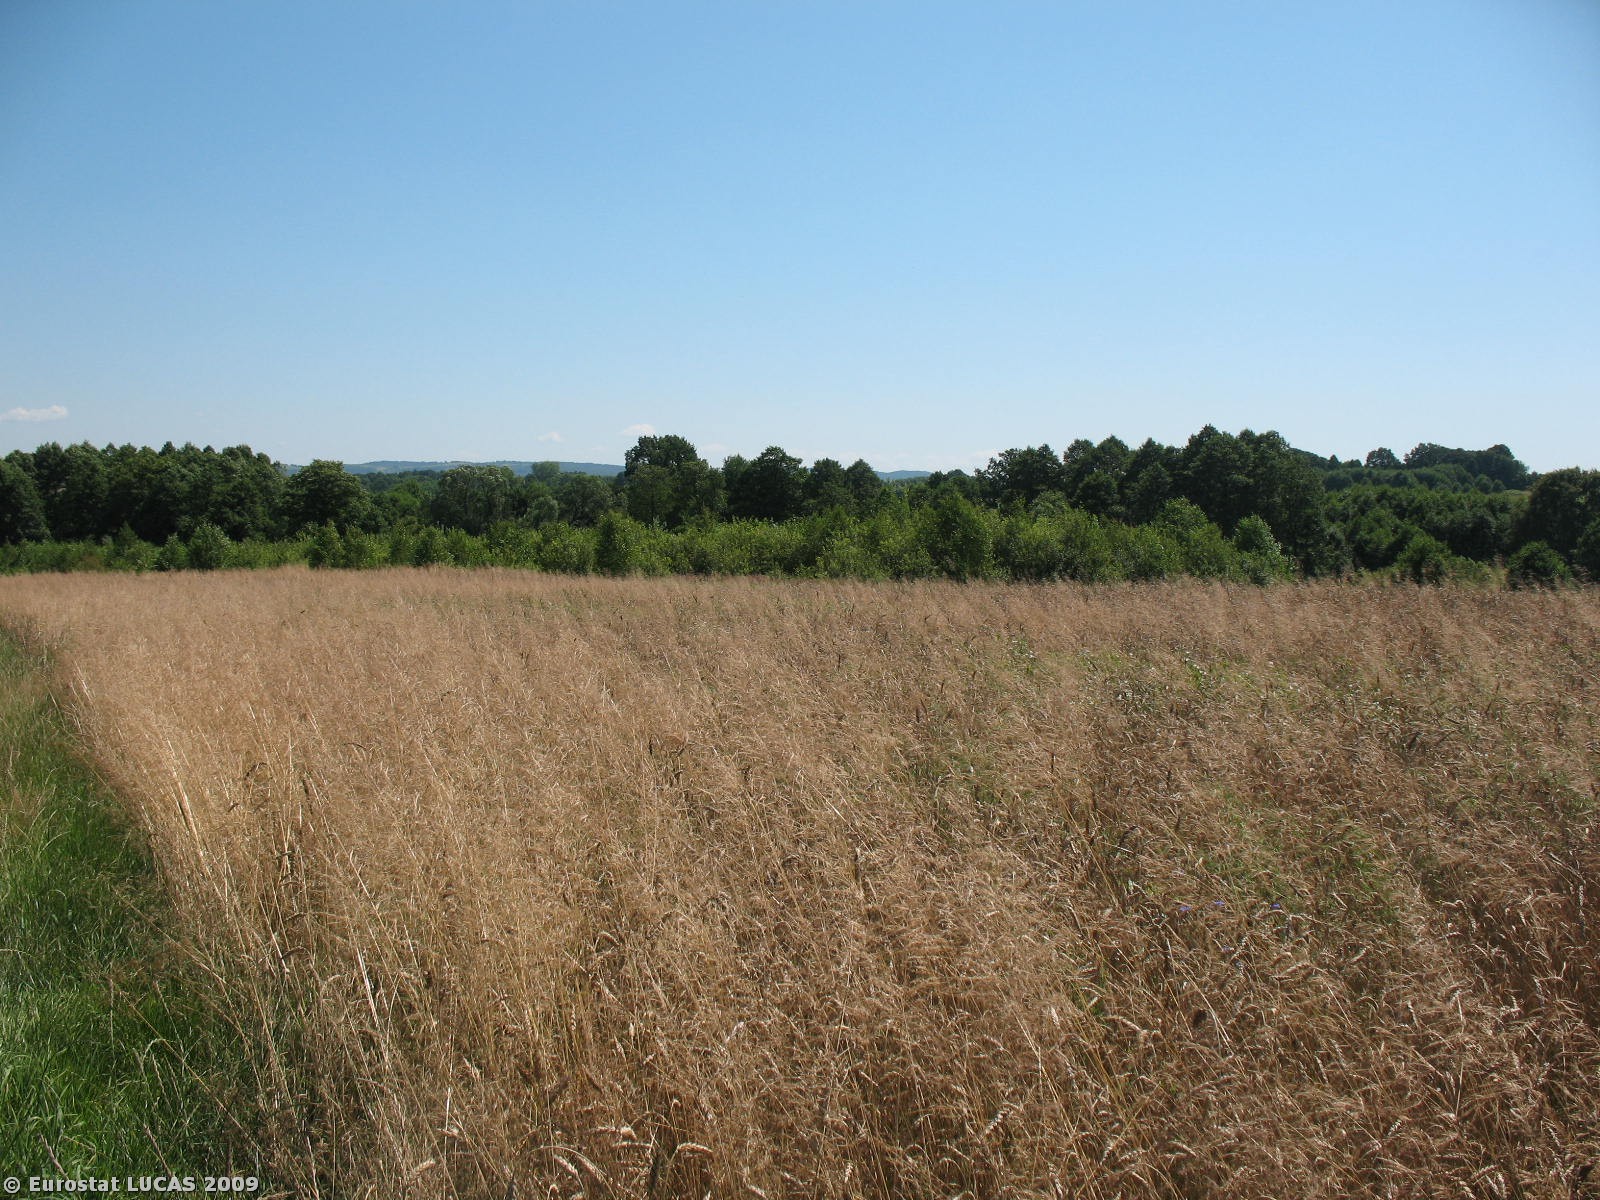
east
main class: Grassland
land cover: Grassland without tree/shrub cover
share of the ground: > 75 %
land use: Agriculture (excluding fallow land and kitchen gardens)
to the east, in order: Grassland without tree/shrub cover; Common wheat; Grassland without tree/shrub cover; Broadleaved woodland; Shrubland with sparse tree cover
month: July
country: PL
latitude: 49.7146
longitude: 21.9699
